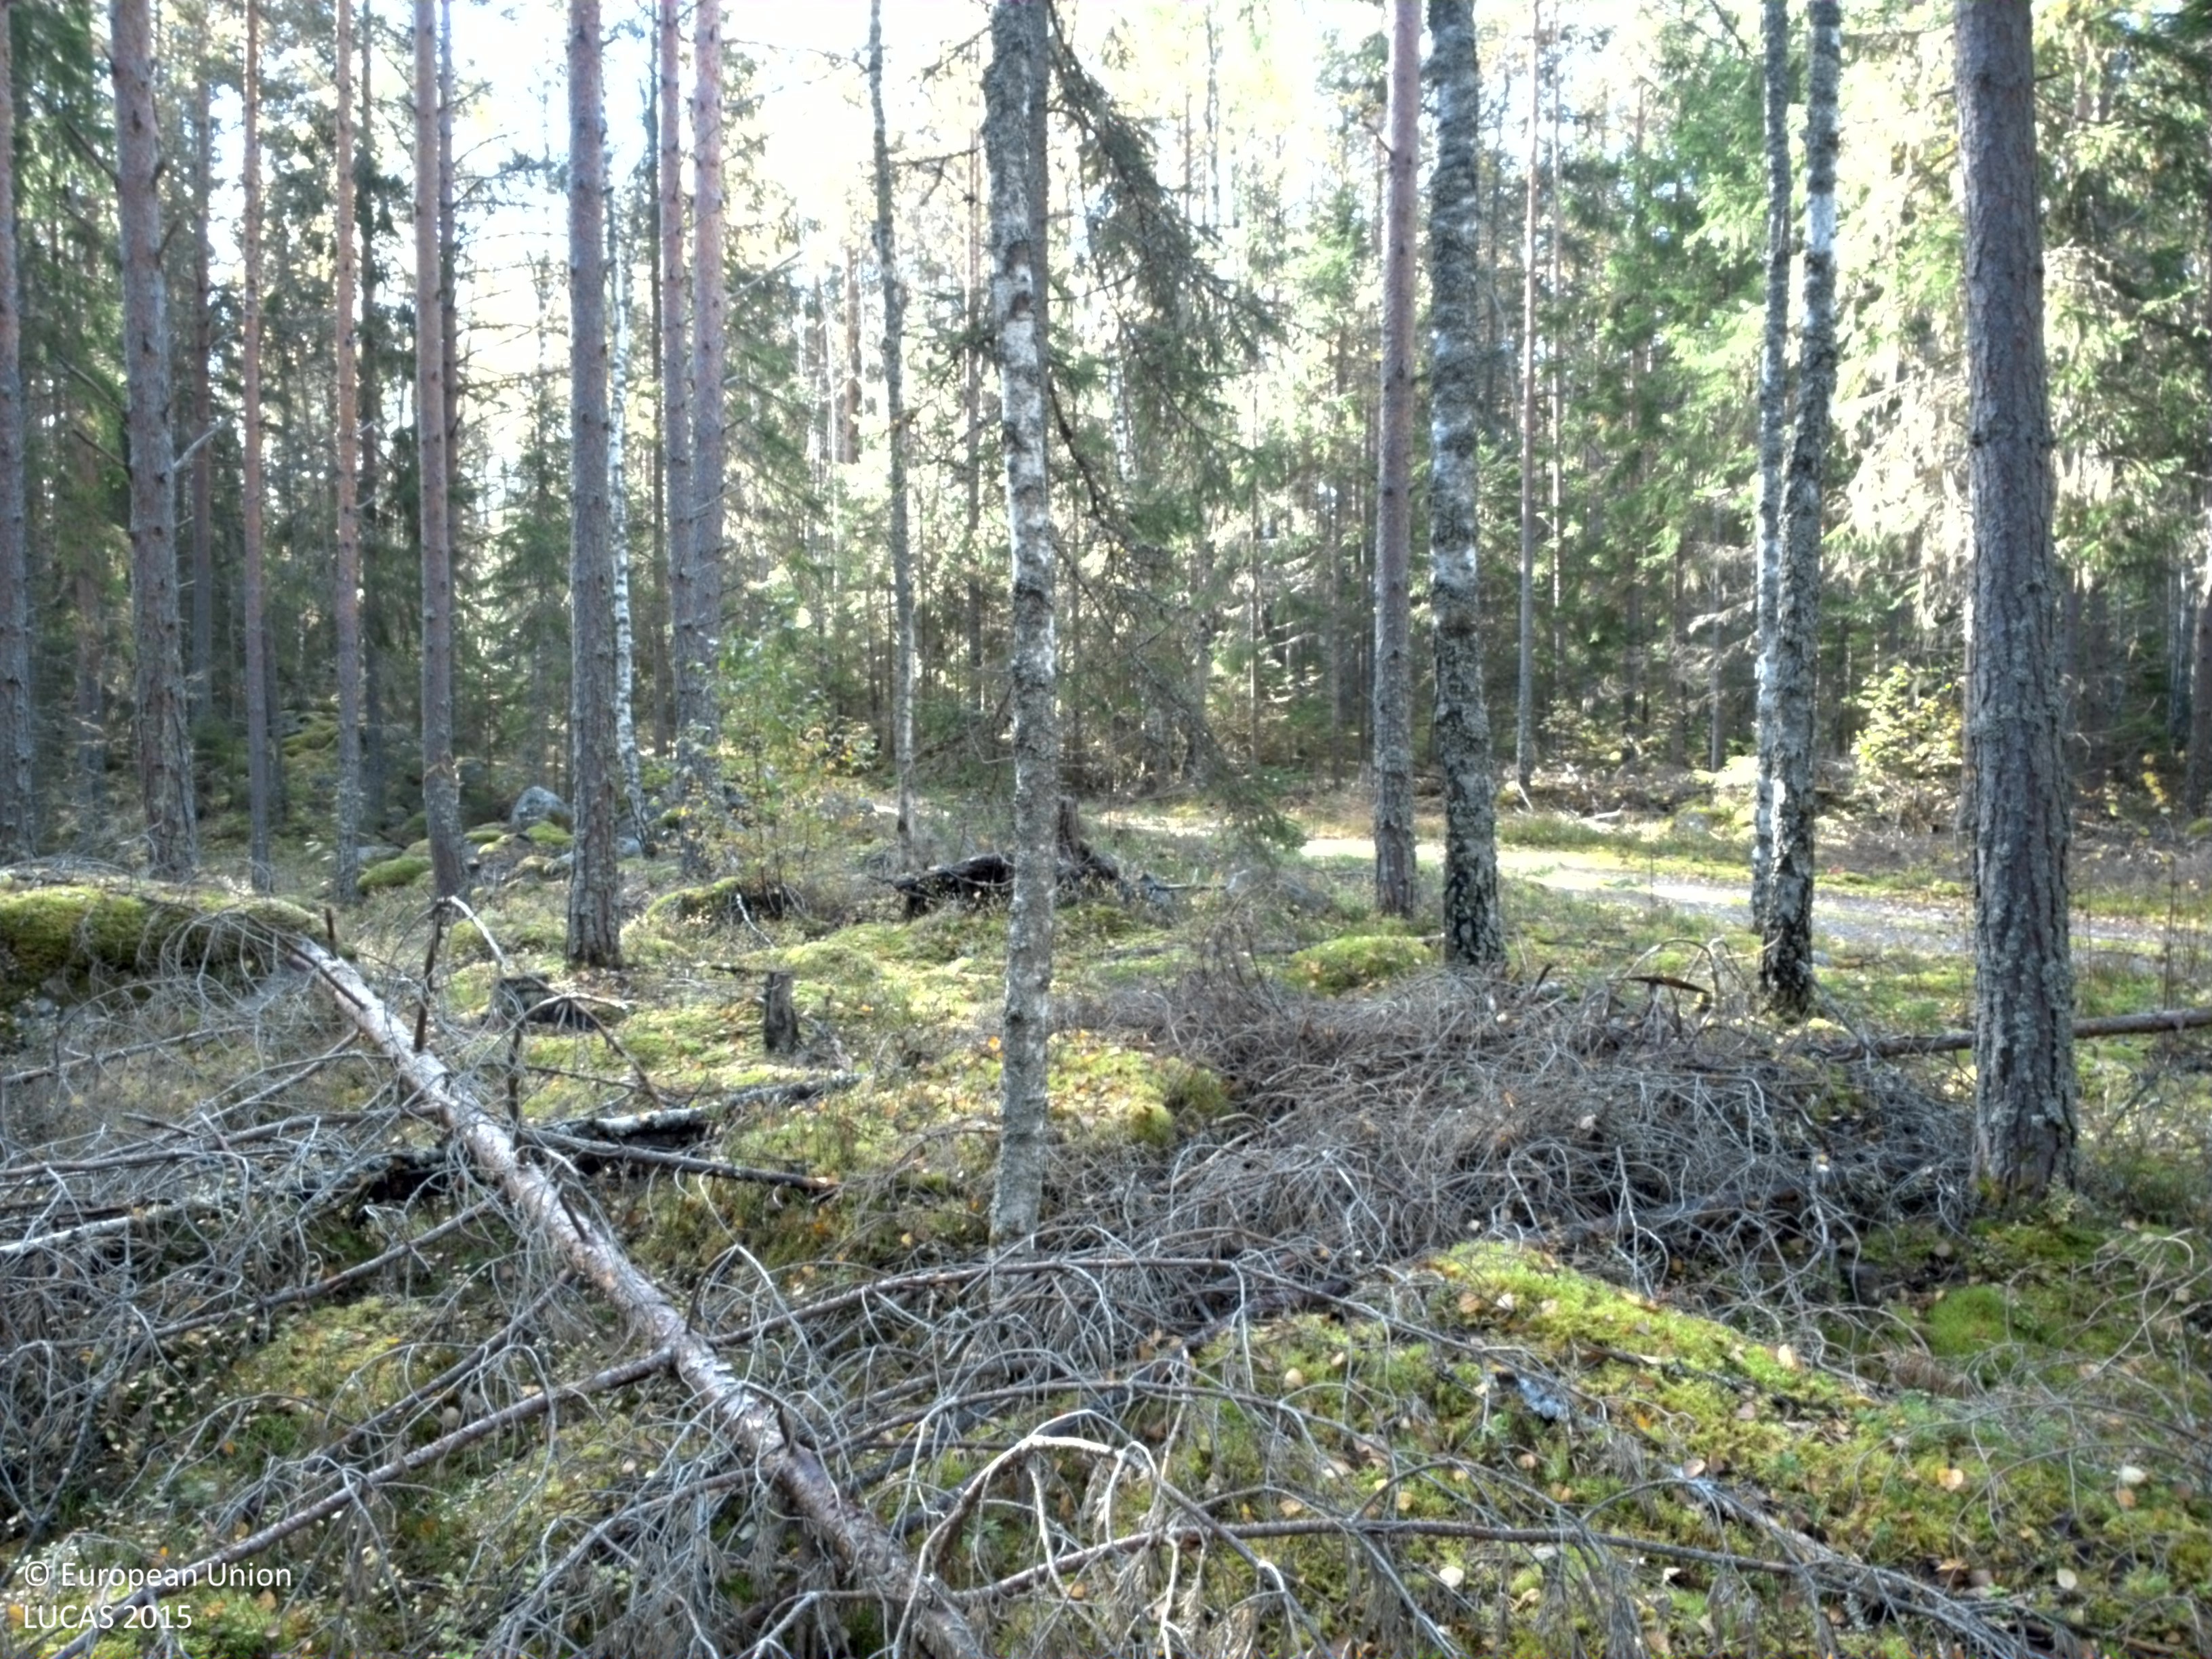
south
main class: Woodland
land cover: Pine dominated coniferous woodland
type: boreal forest
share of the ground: 50 - 75 %
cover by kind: coniferous forest trees 65 %, lichens and mosses 30 %, broadleaved forest trees 5 %
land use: Forestry
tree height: > 5 m
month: September
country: SE
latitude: 60.0160
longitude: 16.4304
